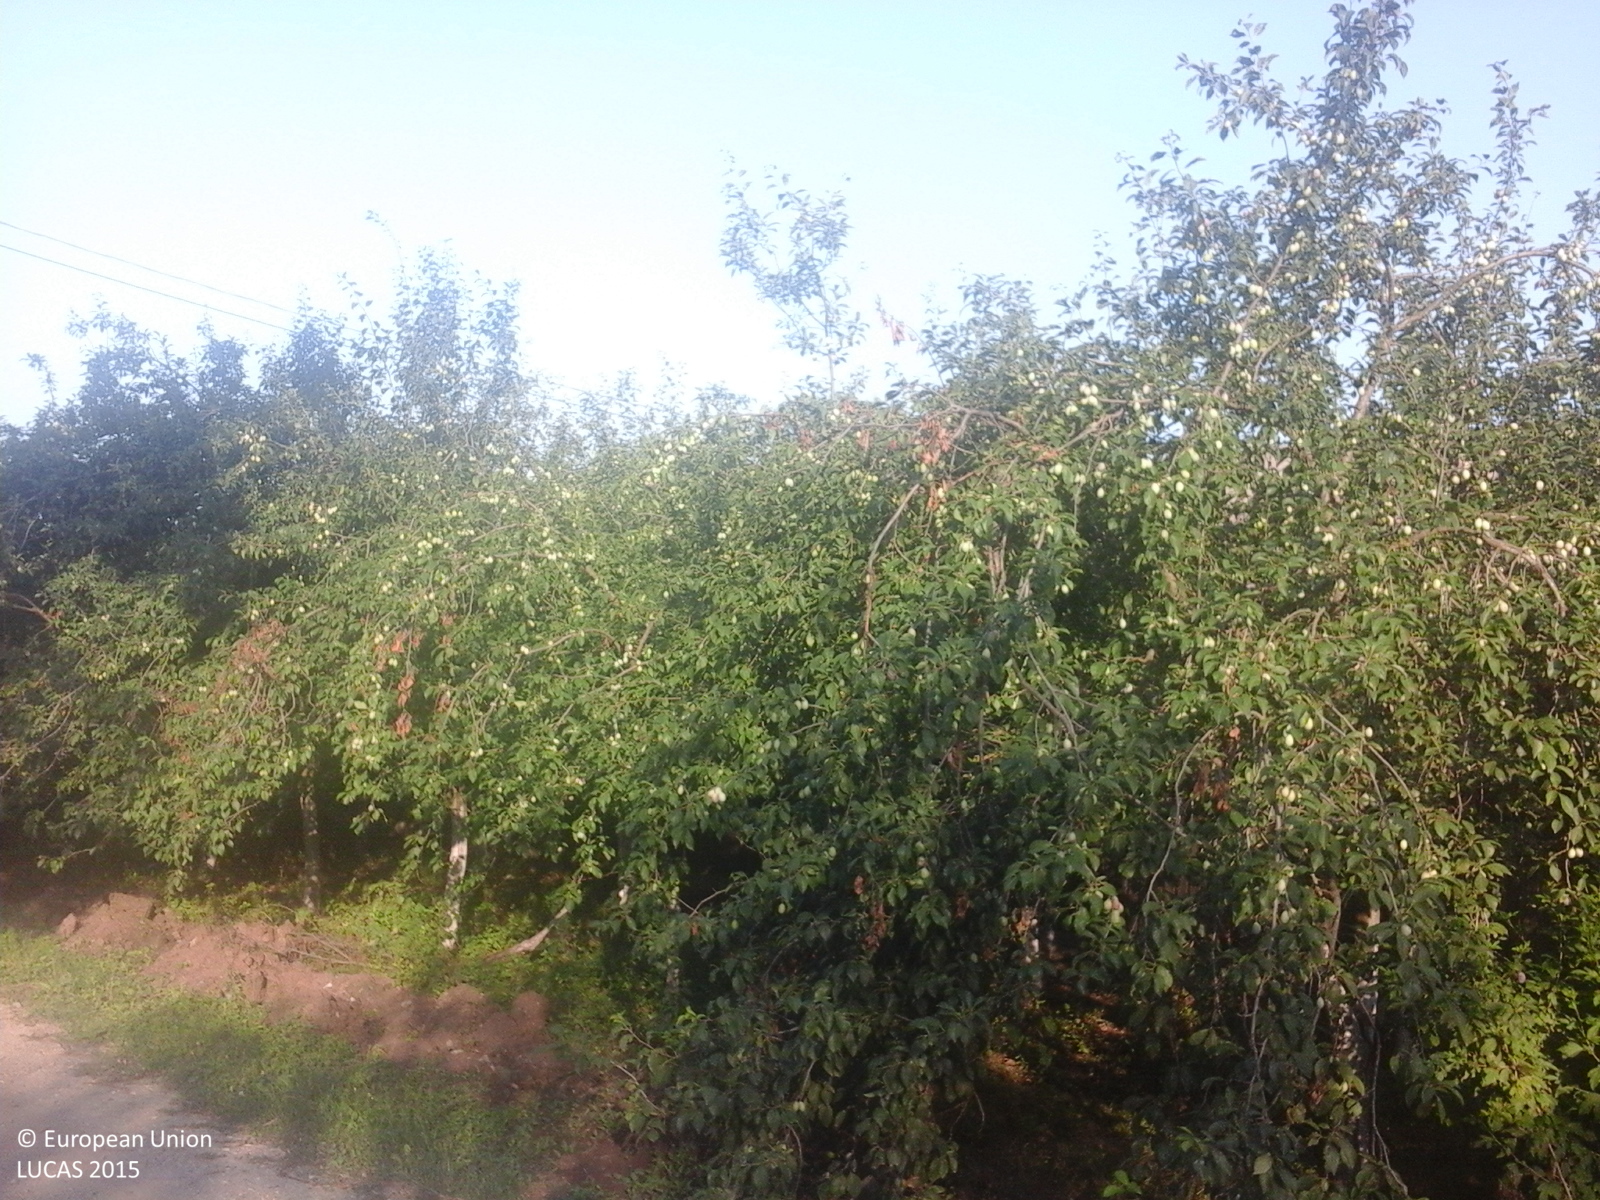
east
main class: Cropland
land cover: Other fresh vegetables
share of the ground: > 75 %
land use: Kitchen garden
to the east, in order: Other fresh vegetables; Artificial constructions in urban areas; Maize; Electric lines; Maize
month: July
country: RO
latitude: 43.9541
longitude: 25.9344
